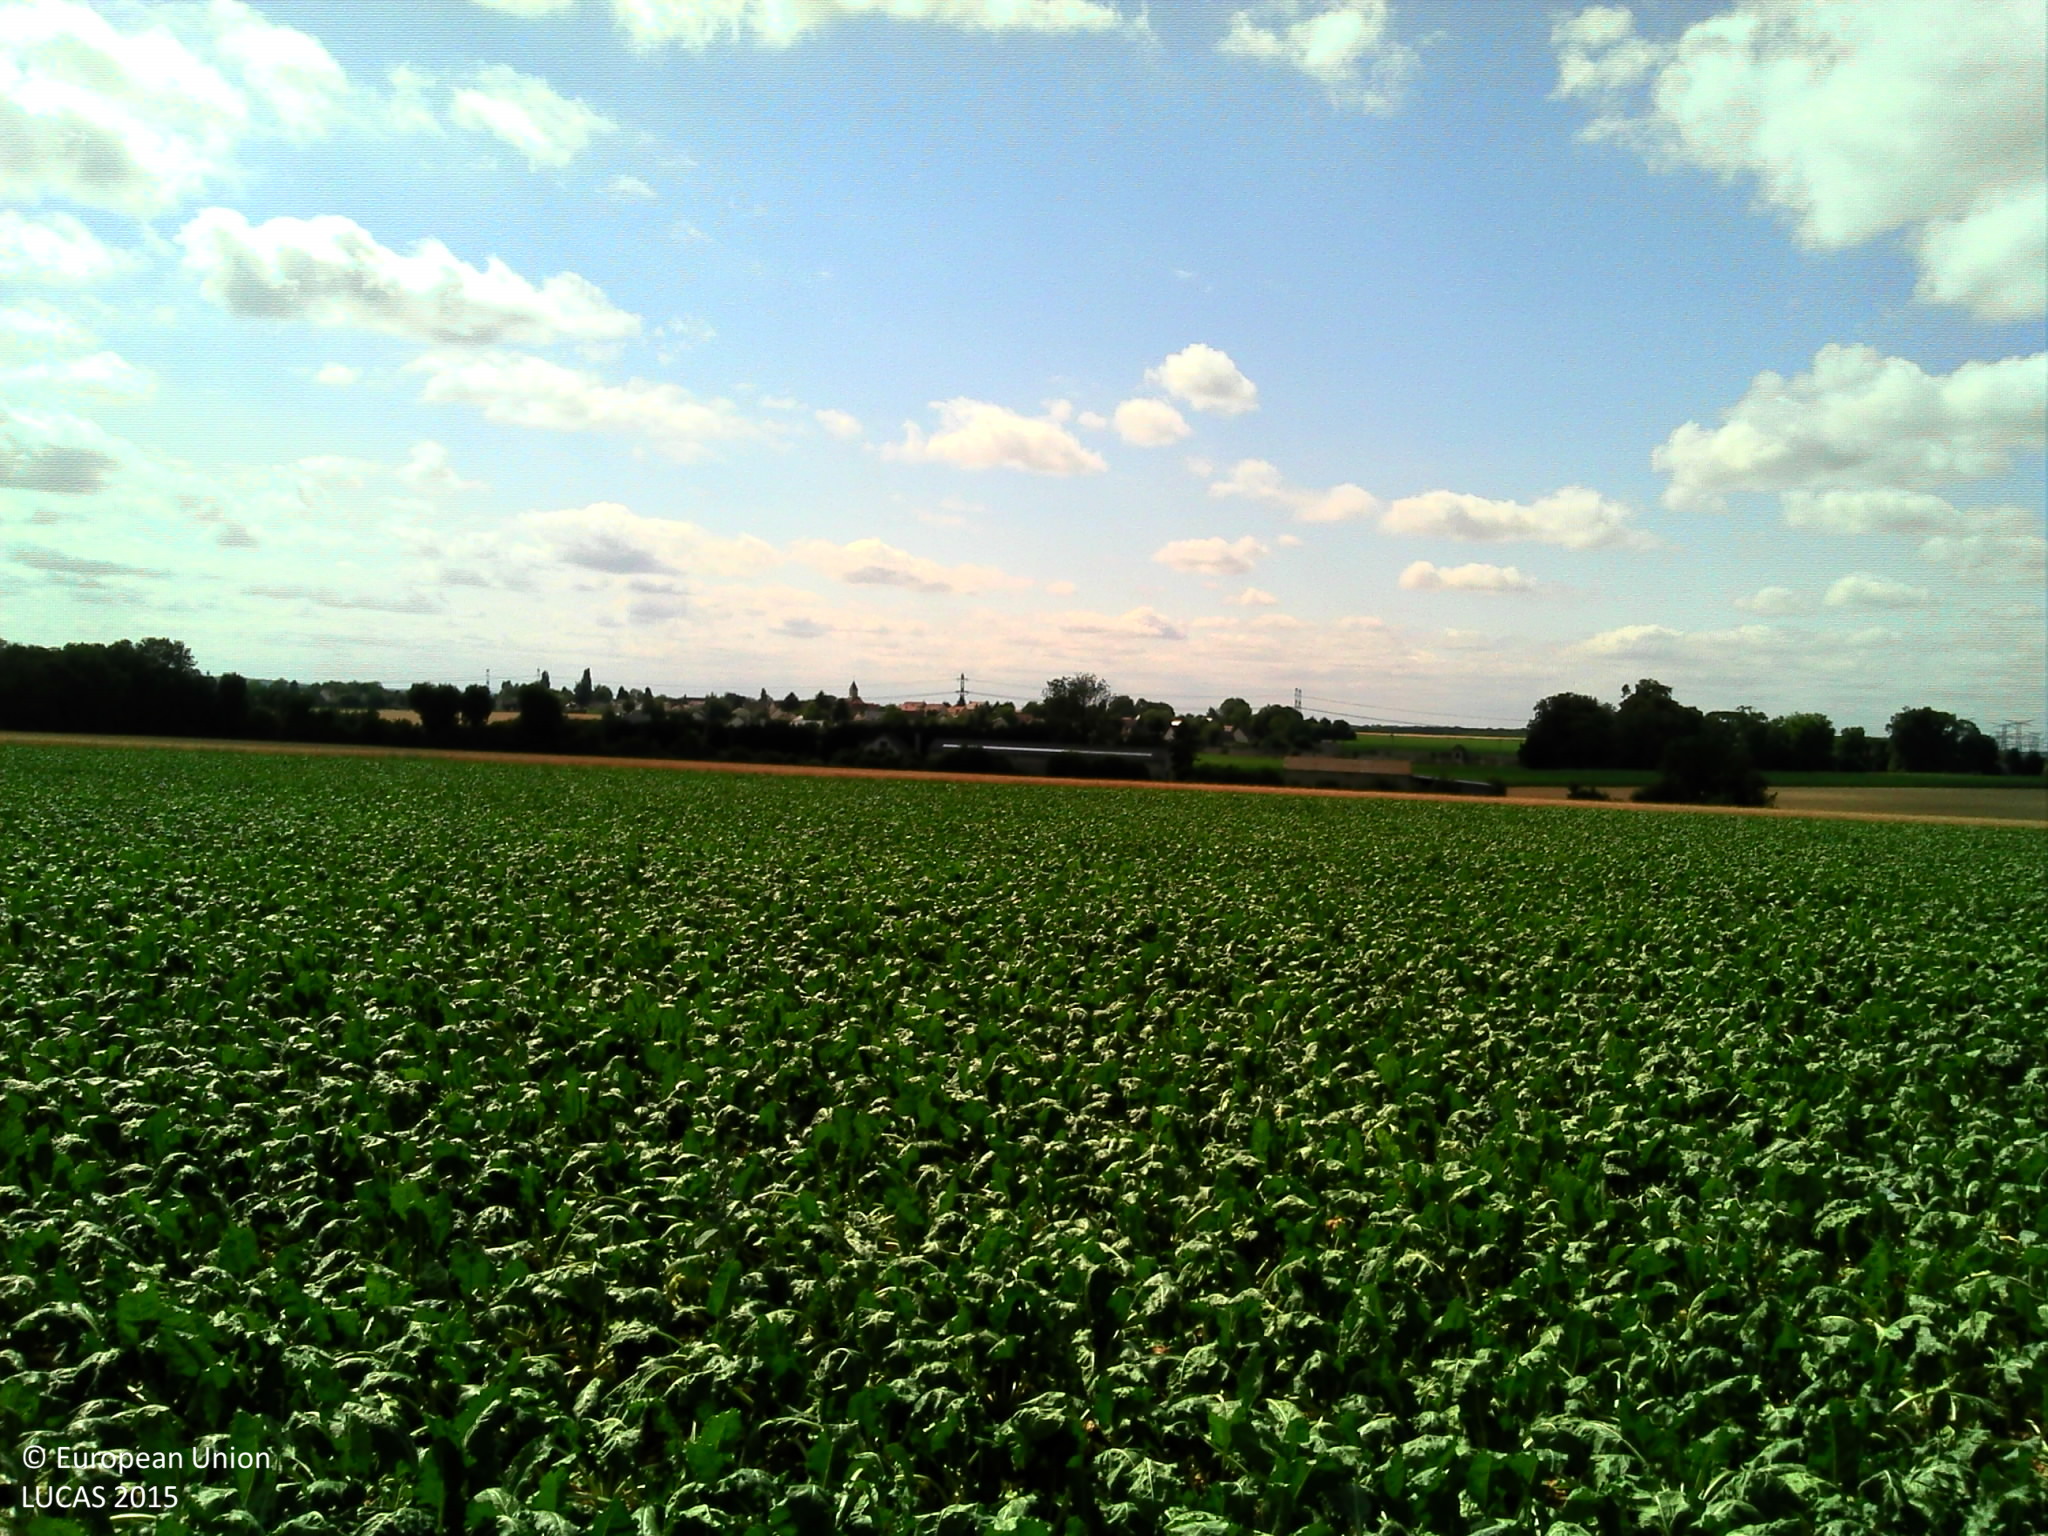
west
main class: Cropland
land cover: Sugar beet
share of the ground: > 75 %
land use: Agriculture (excluding fallow land and kitchen gardens)
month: July
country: FR
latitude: 49.2001
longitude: 2.2879
